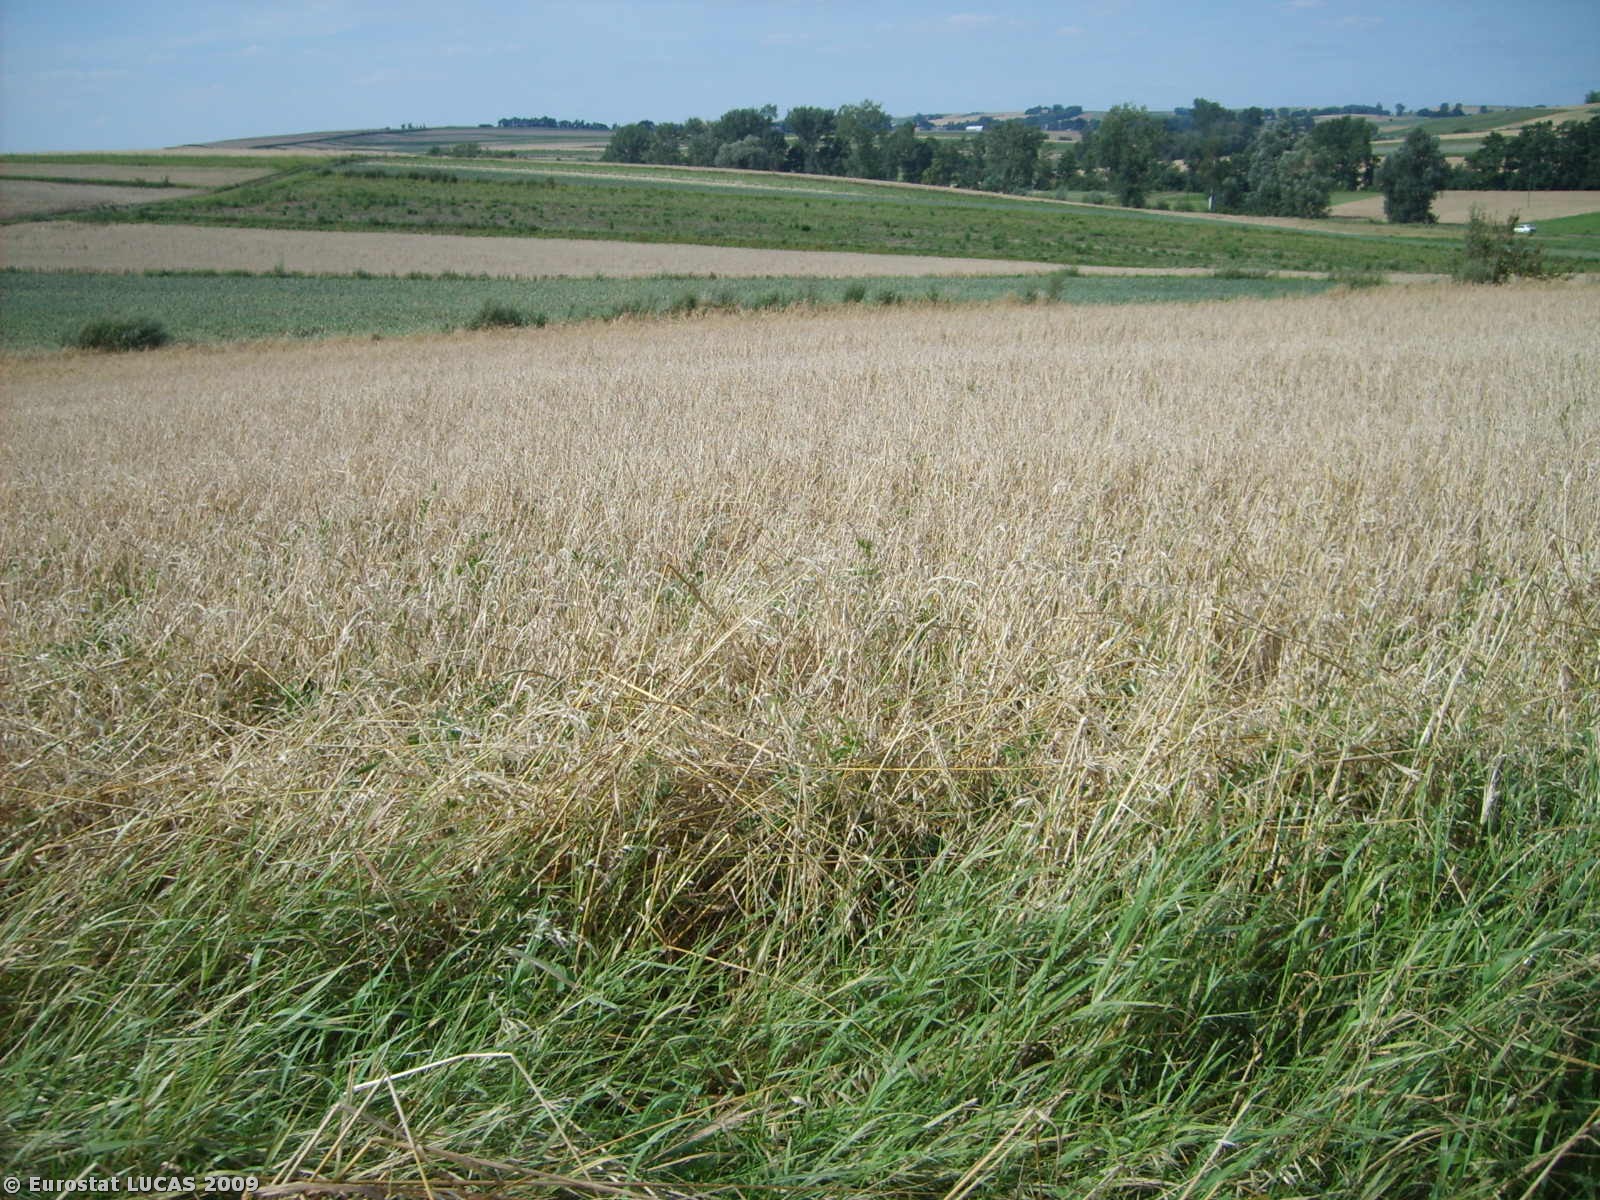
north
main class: Cropland
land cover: Mixed cereals for fodder
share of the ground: 25 - 50 %
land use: Agriculture (excluding fallow land and kitchen gardens)
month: July
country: PL
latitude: 50.2105
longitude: 20.2502
